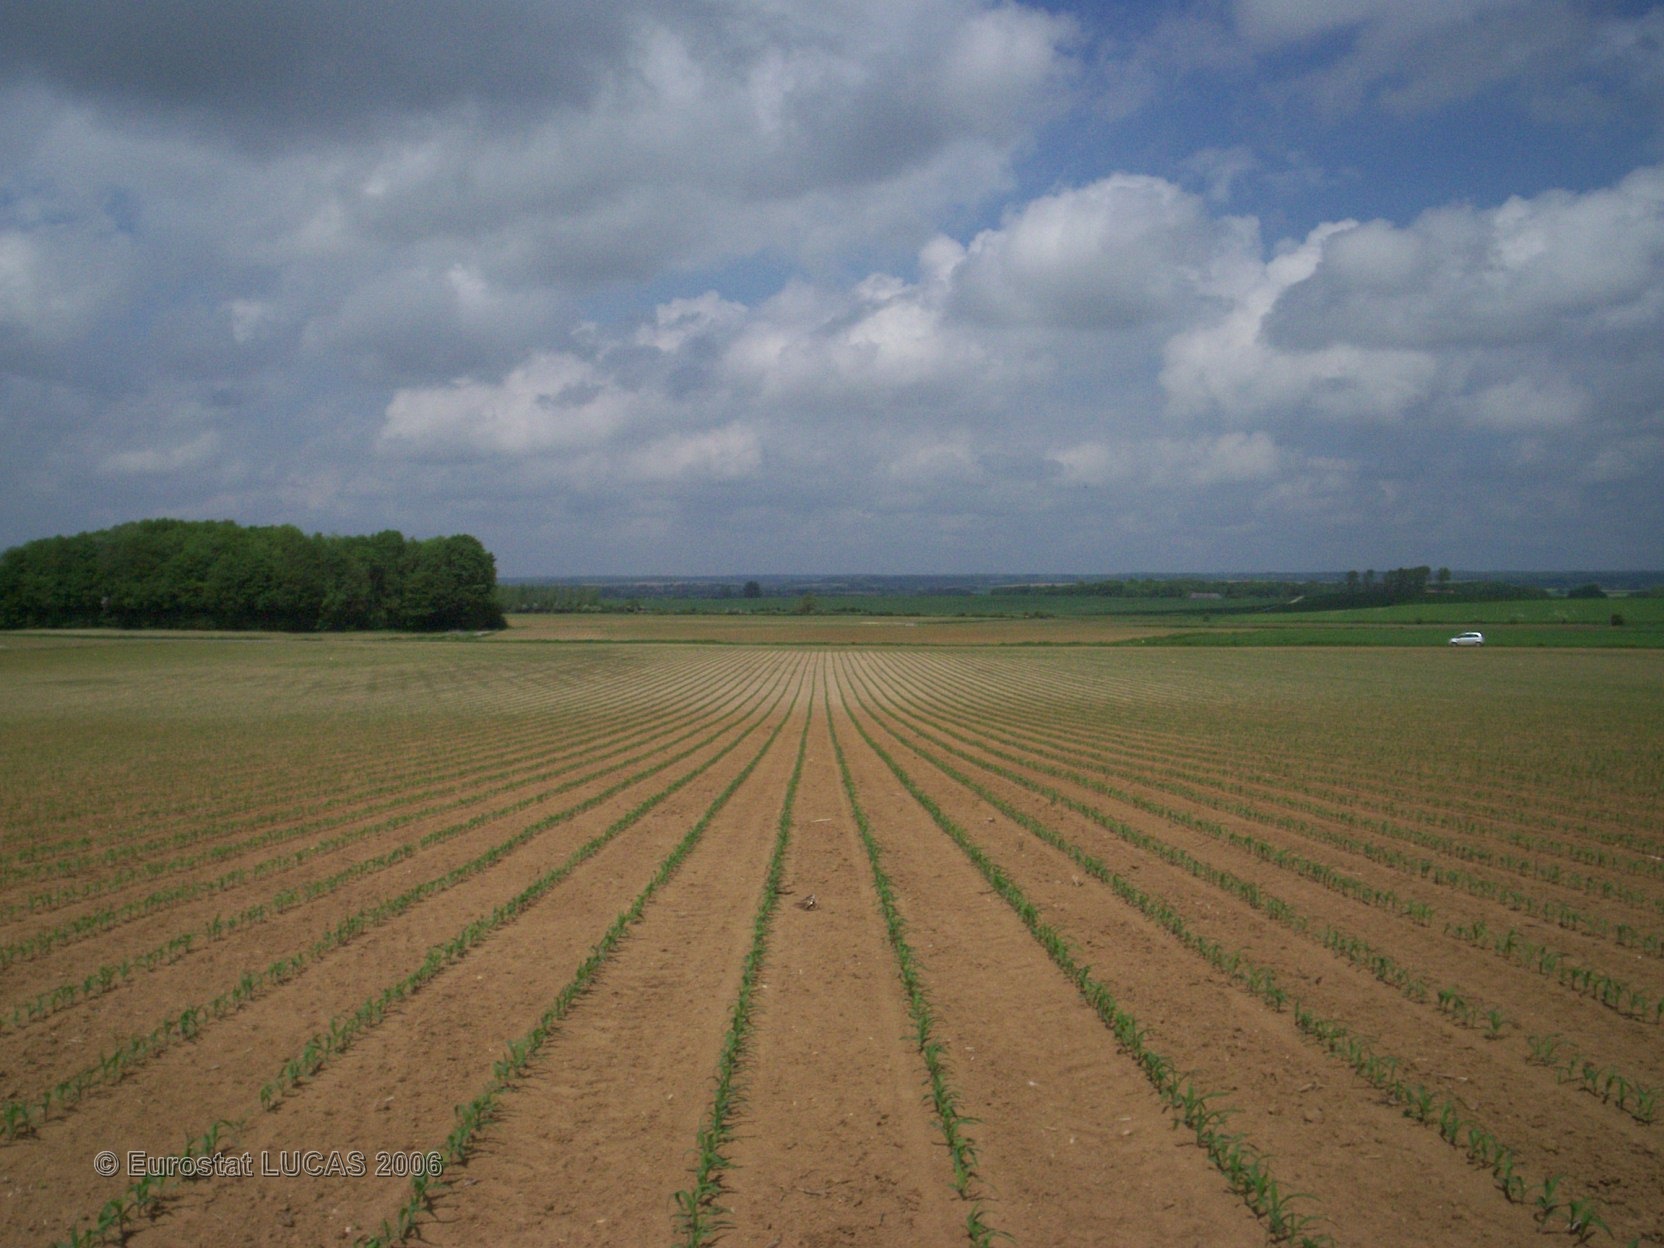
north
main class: Cropland
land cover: Maize
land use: Agriculture (excluding fallow land and kitchen gardens)
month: May
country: FR
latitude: 49.5432
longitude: 4.4265
